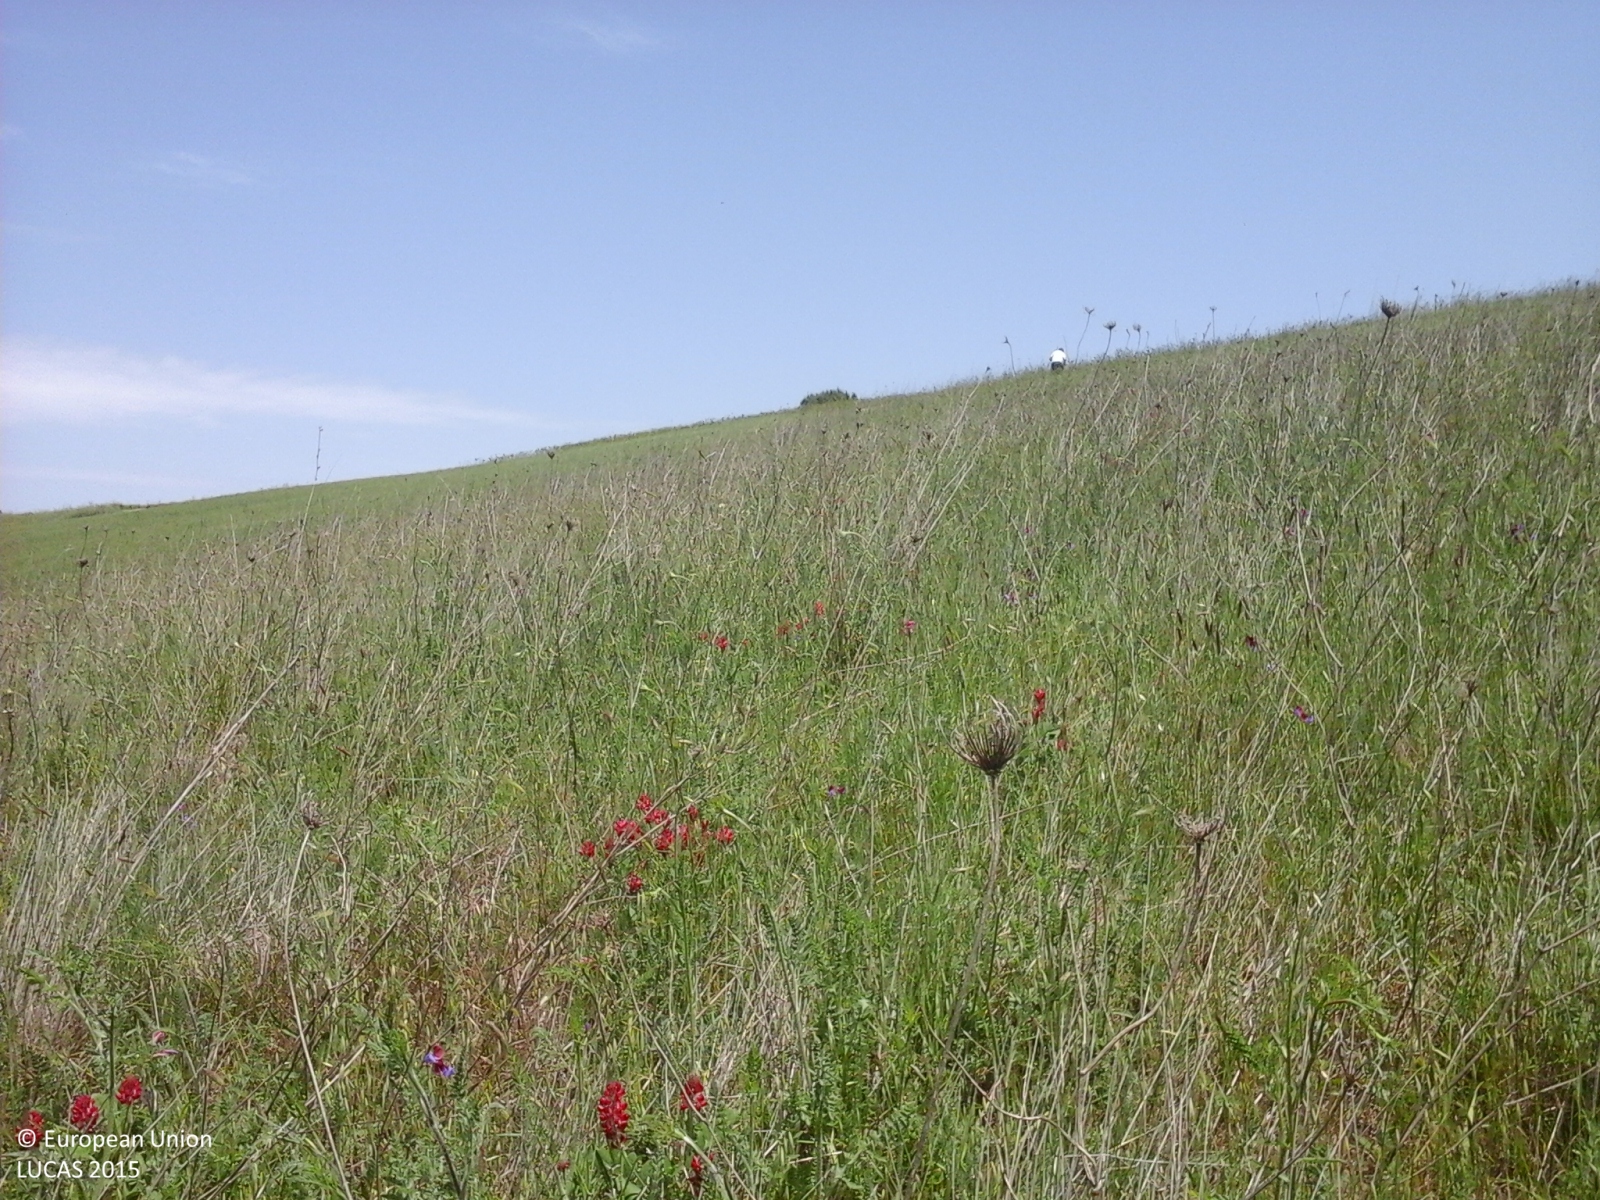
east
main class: Grassland
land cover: Spontaneously vegetated surfaces
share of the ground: > 75 %
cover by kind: herbaceous plants 100 %
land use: Fallow land
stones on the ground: < 10 %
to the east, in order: Spontaneously vegetated surfaces; Grass margins; Durum wheat; Grassland without tree/shrub cover; Artificial constructions in urban areas; Grassland without tree/shrub cover; Durum wheat
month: May
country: IT
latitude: 37.7704
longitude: 14.0465
